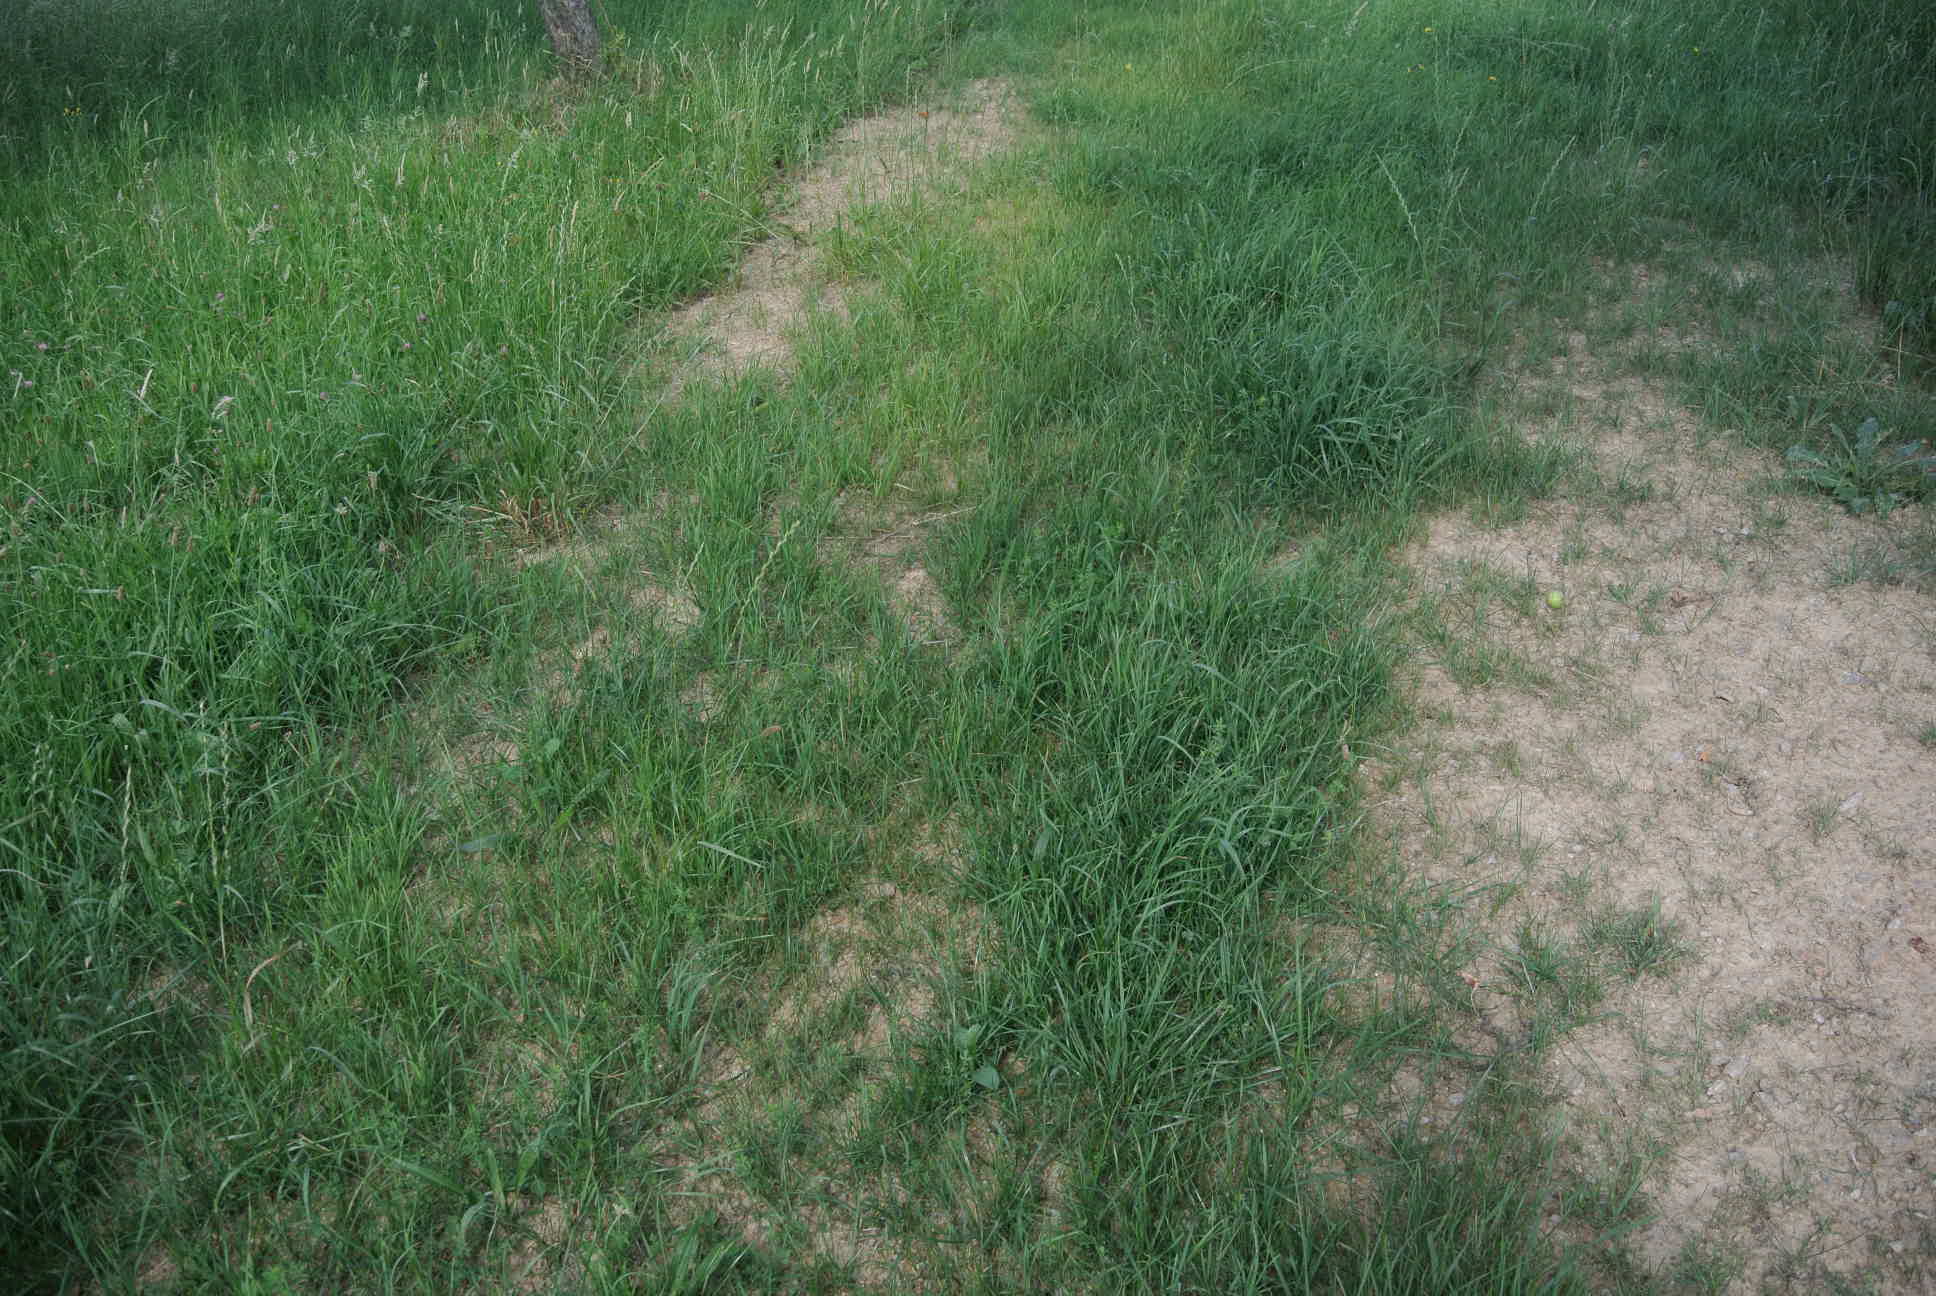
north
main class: Cropland
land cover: Apple fruit
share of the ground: > 75 %
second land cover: Spontaneously vegetated surfaces
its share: > 75 %
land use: Kitchen garden
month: July
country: AT
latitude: 47.6777
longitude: 16.0634
